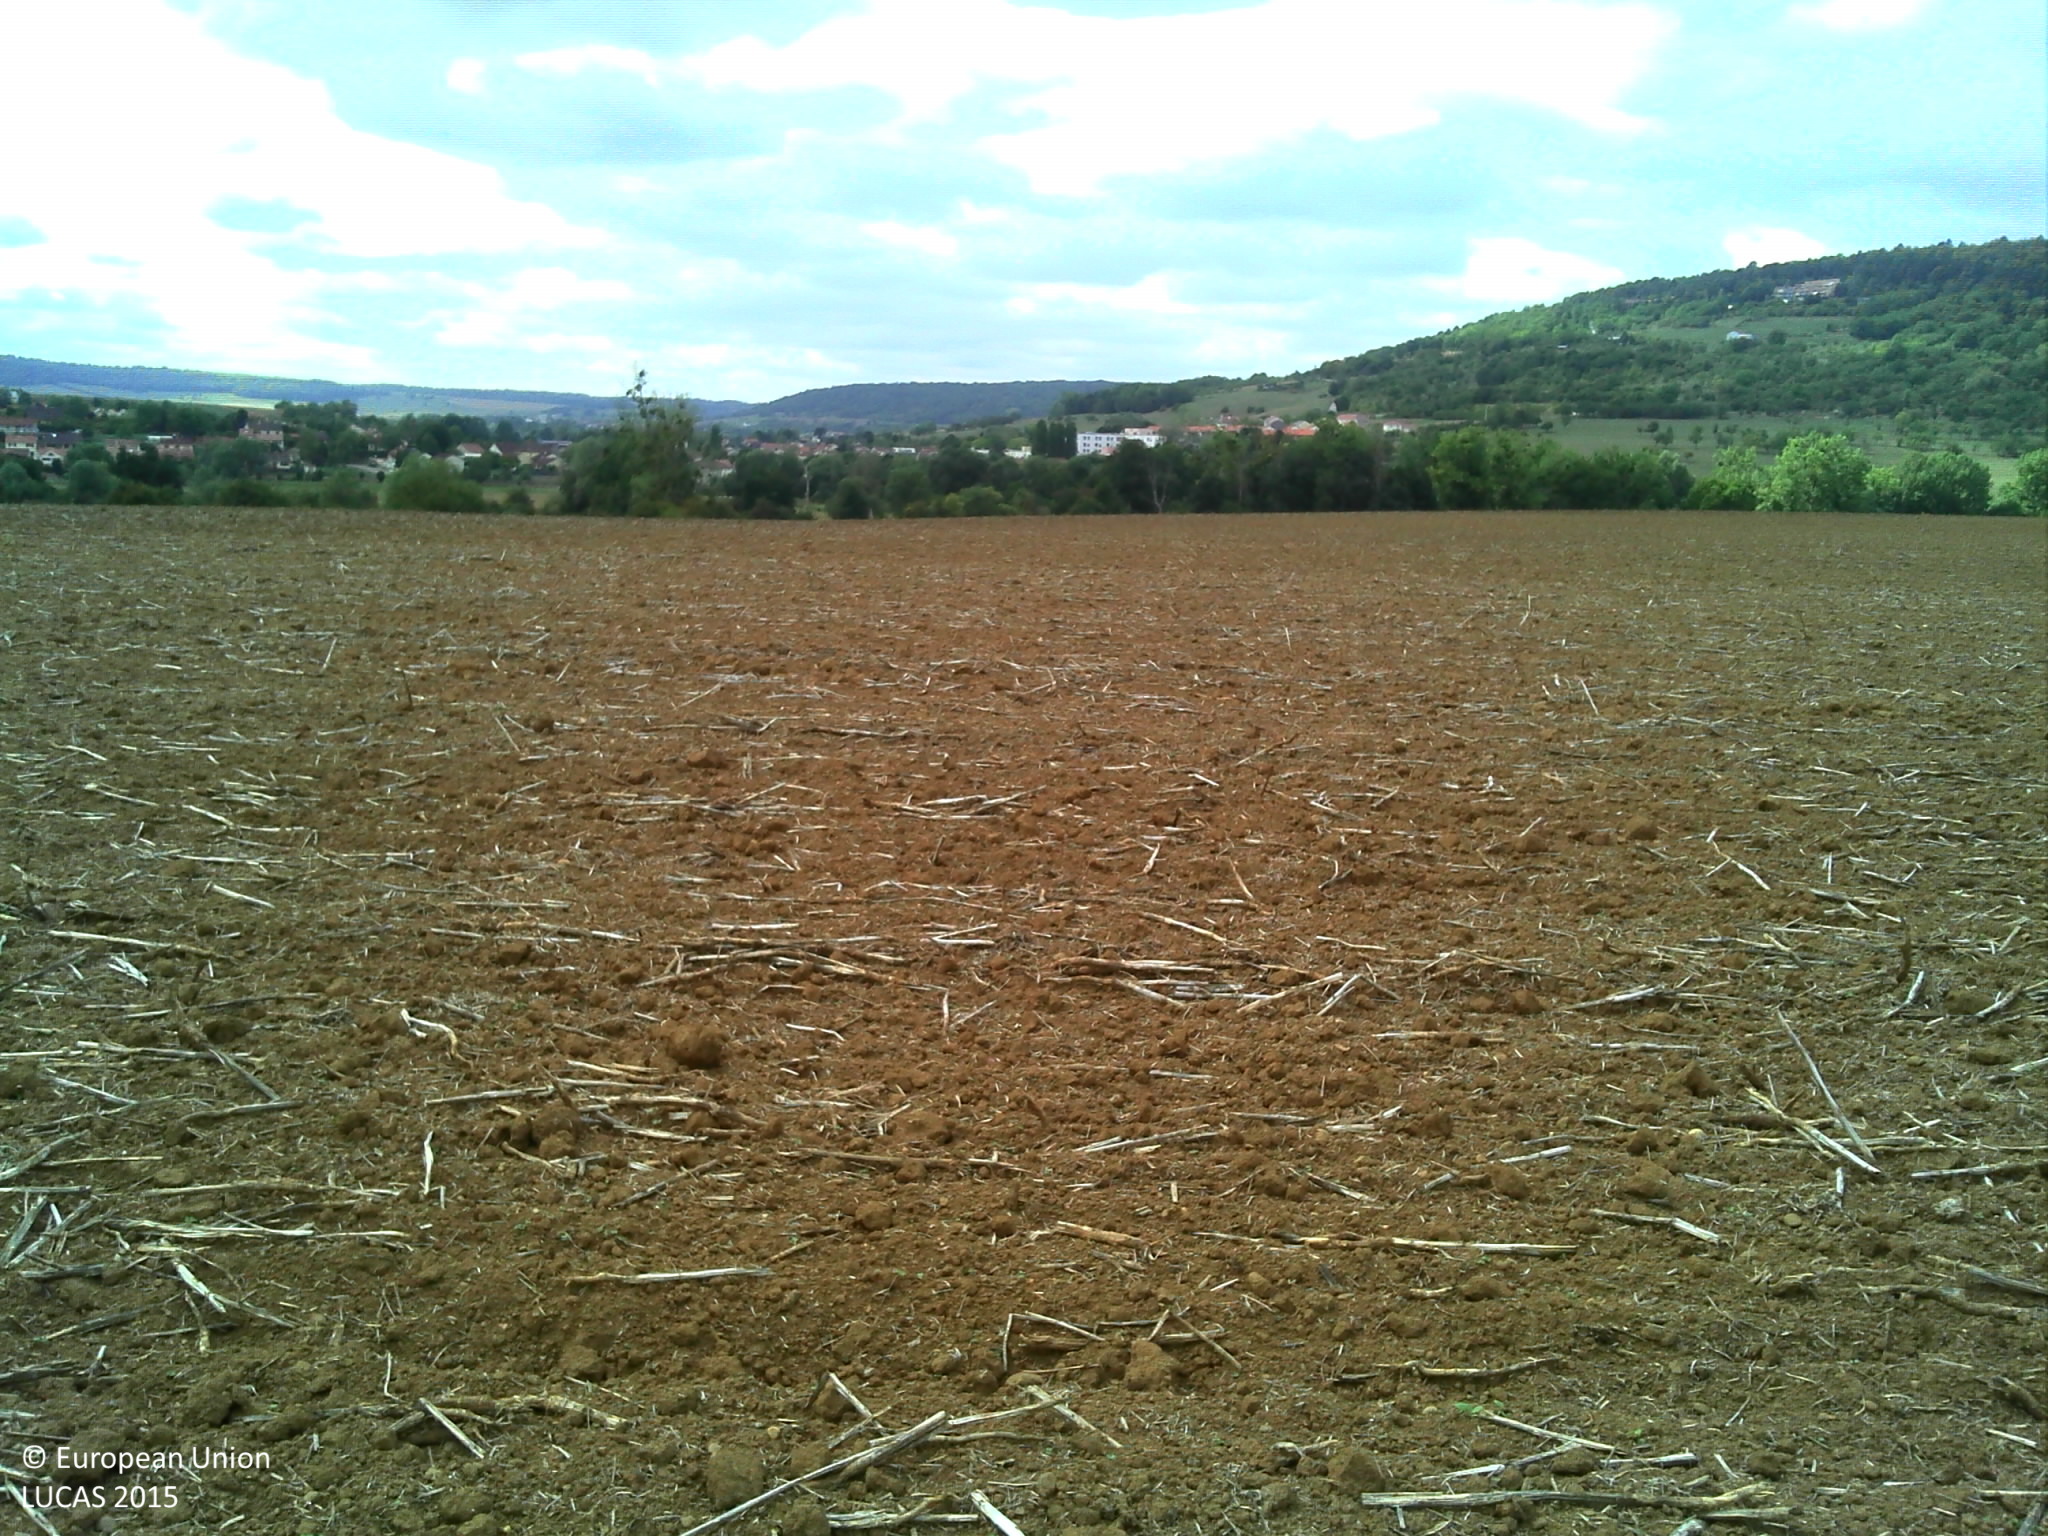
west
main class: Cropland
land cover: Rape and turnip rape
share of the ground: < 10 %
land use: Agriculture (excluding fallow land and kitchen gardens)
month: September
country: FR
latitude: 48.5872
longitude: 6.1092
